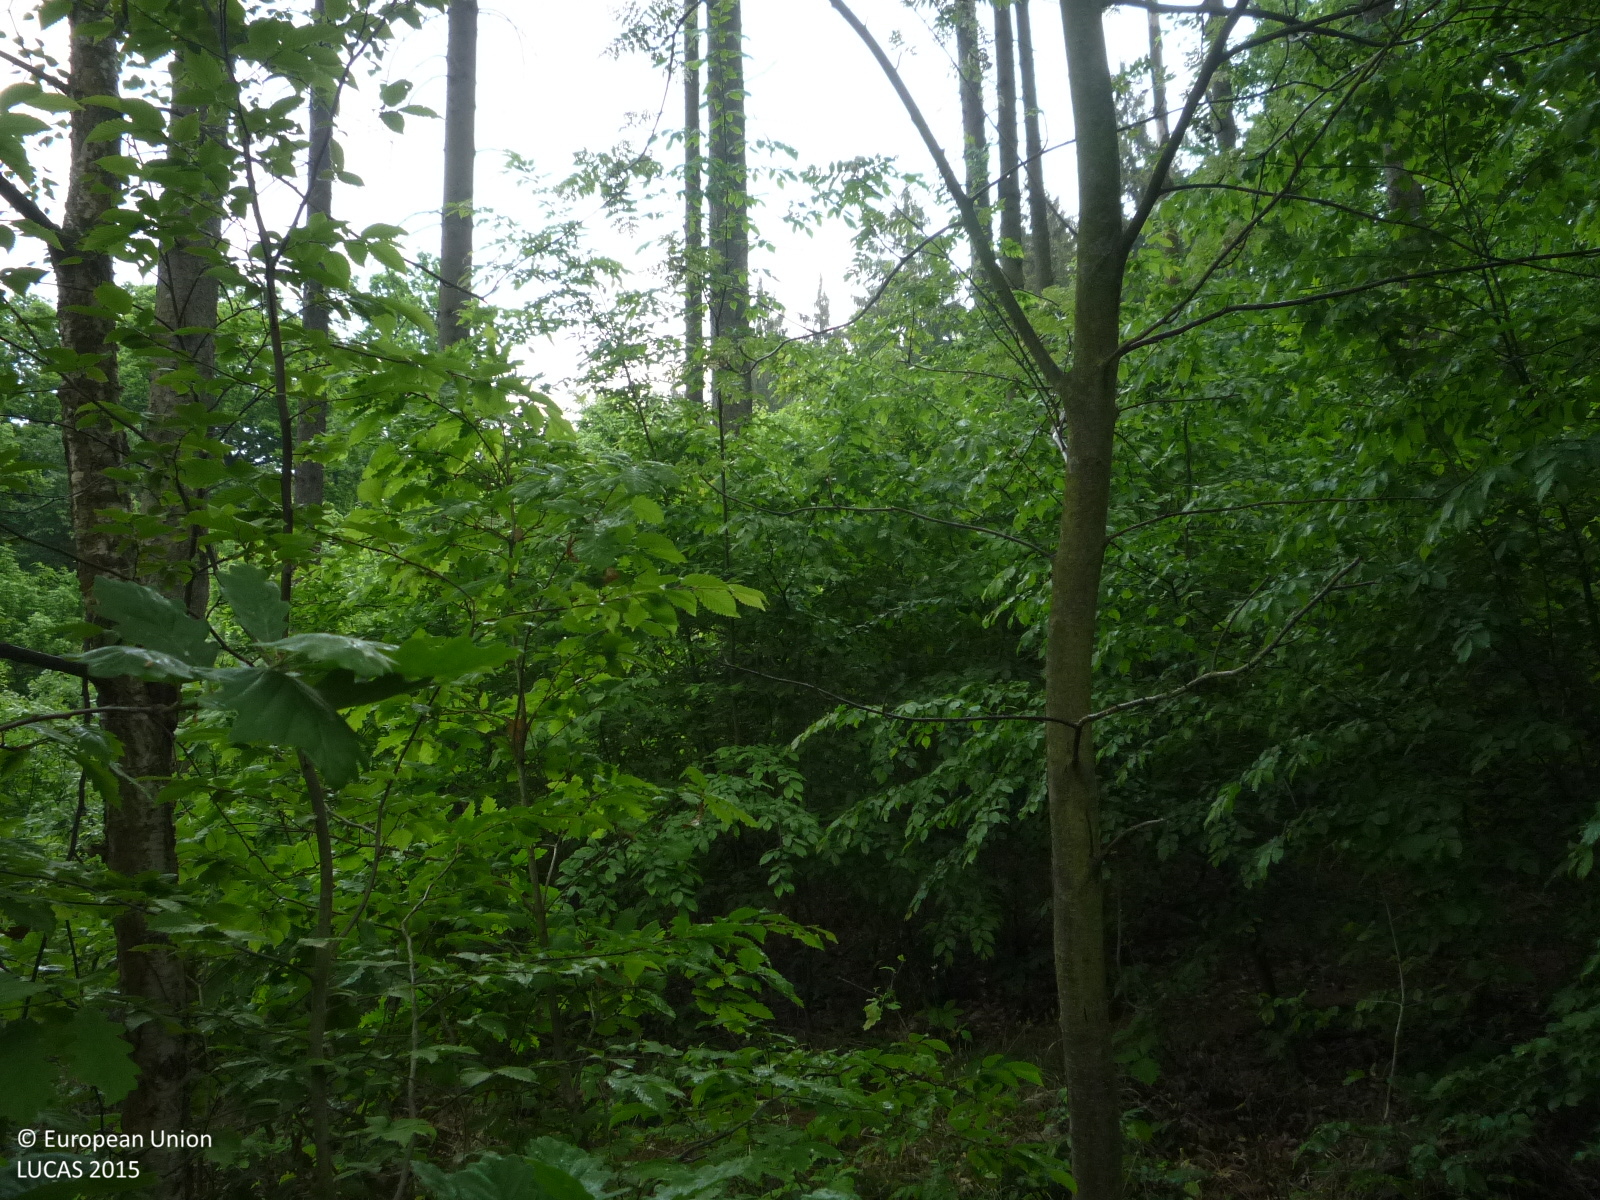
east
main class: Woodland
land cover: Spruce dominated mixed woodland
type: hemiboreal forest and nemoral coniferous forest and mixed broadleaved-coniferous forest
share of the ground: > 75 %
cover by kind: coniferous forest trees 60 %, broadleaved forest trees 30 %, herbaceous plants 5 %, unconsolidated bare surface 5 %
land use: Forestry
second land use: Sport
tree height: > 5 m
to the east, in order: Spruce dominated mixed woodland; Broadleaved woodland; Spruce dominated mixed woodland; Spruce dominated coniferous woodland; Paved roads, cycling and walking lanes; Other mixed woodland; Artificial constructions in urban areas
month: May
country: CZ
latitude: 50.0241
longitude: 14.4822
